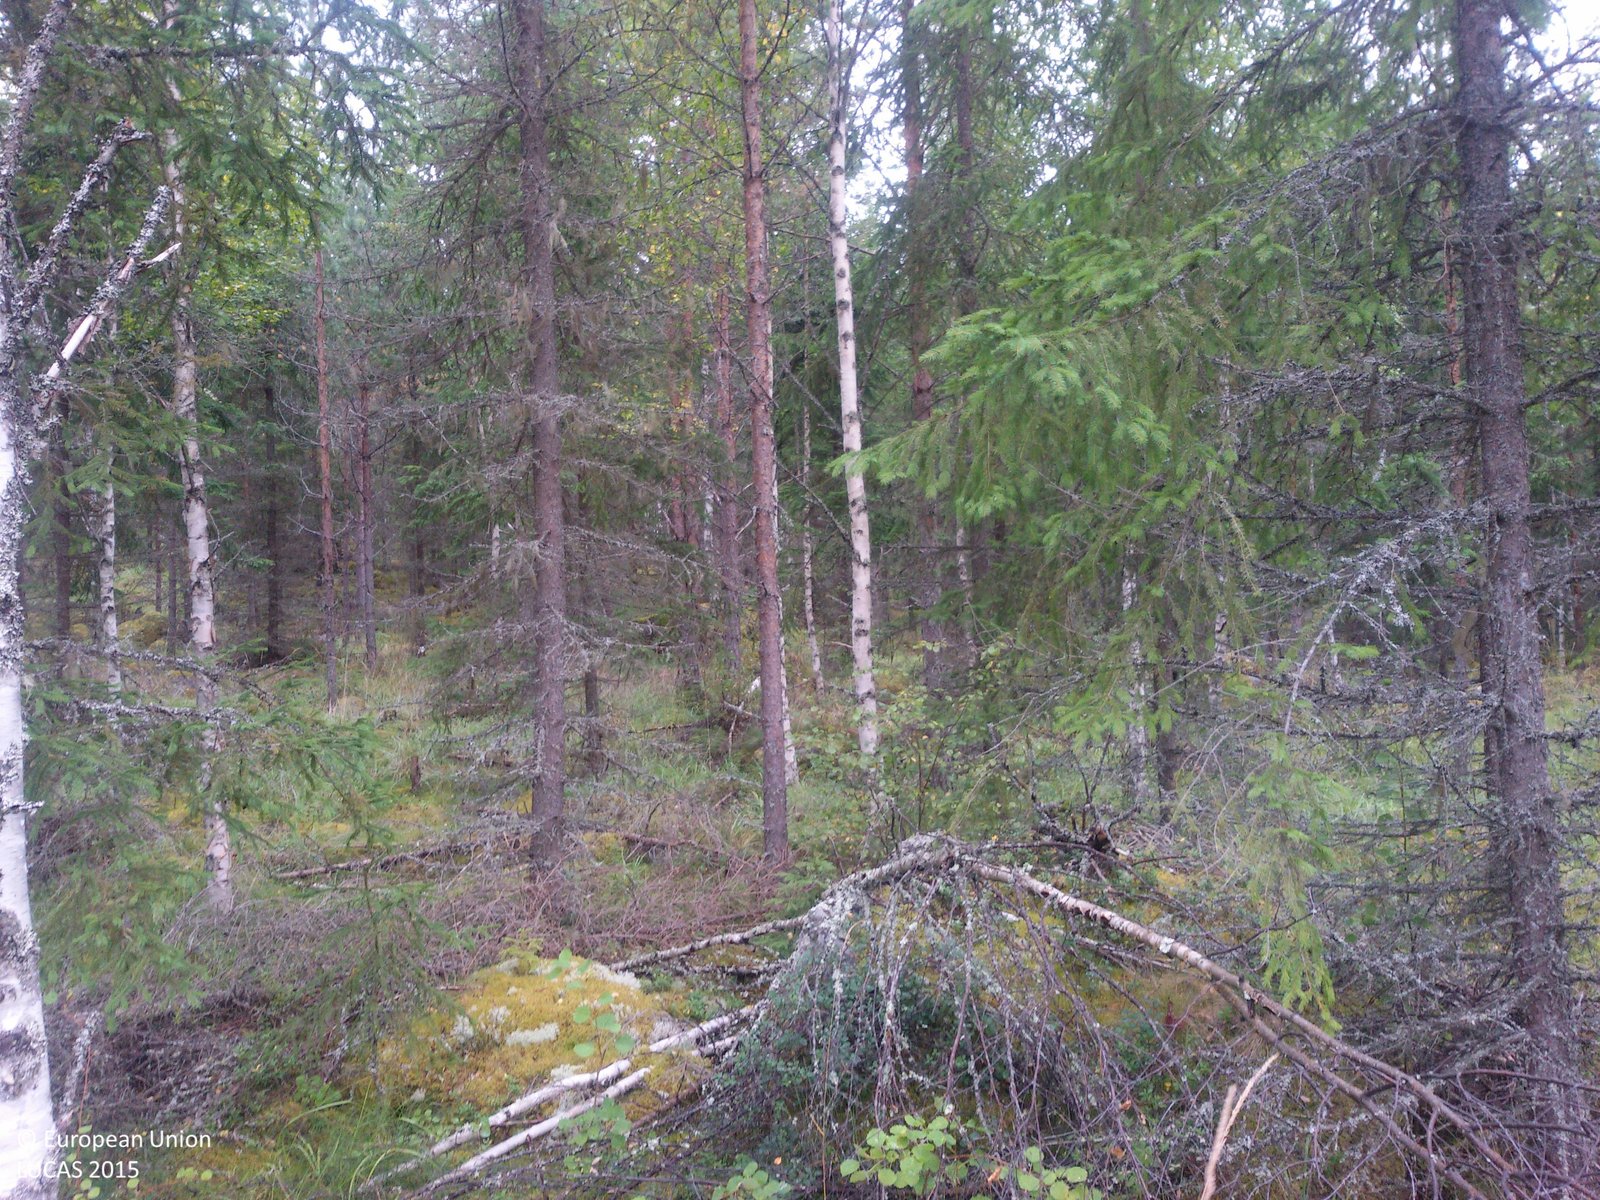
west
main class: Woodland
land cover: Spruce dominated mixed woodland
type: boreal forest
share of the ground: 50 - 75 %
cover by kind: coniferous forest trees 35 %, broadleaved forest trees 35 %, herbaceous plants 20 %, lichens and mosses 10 %
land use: Forestry
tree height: > 5 m
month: September
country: SE
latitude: 60.8193
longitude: 15.8151
